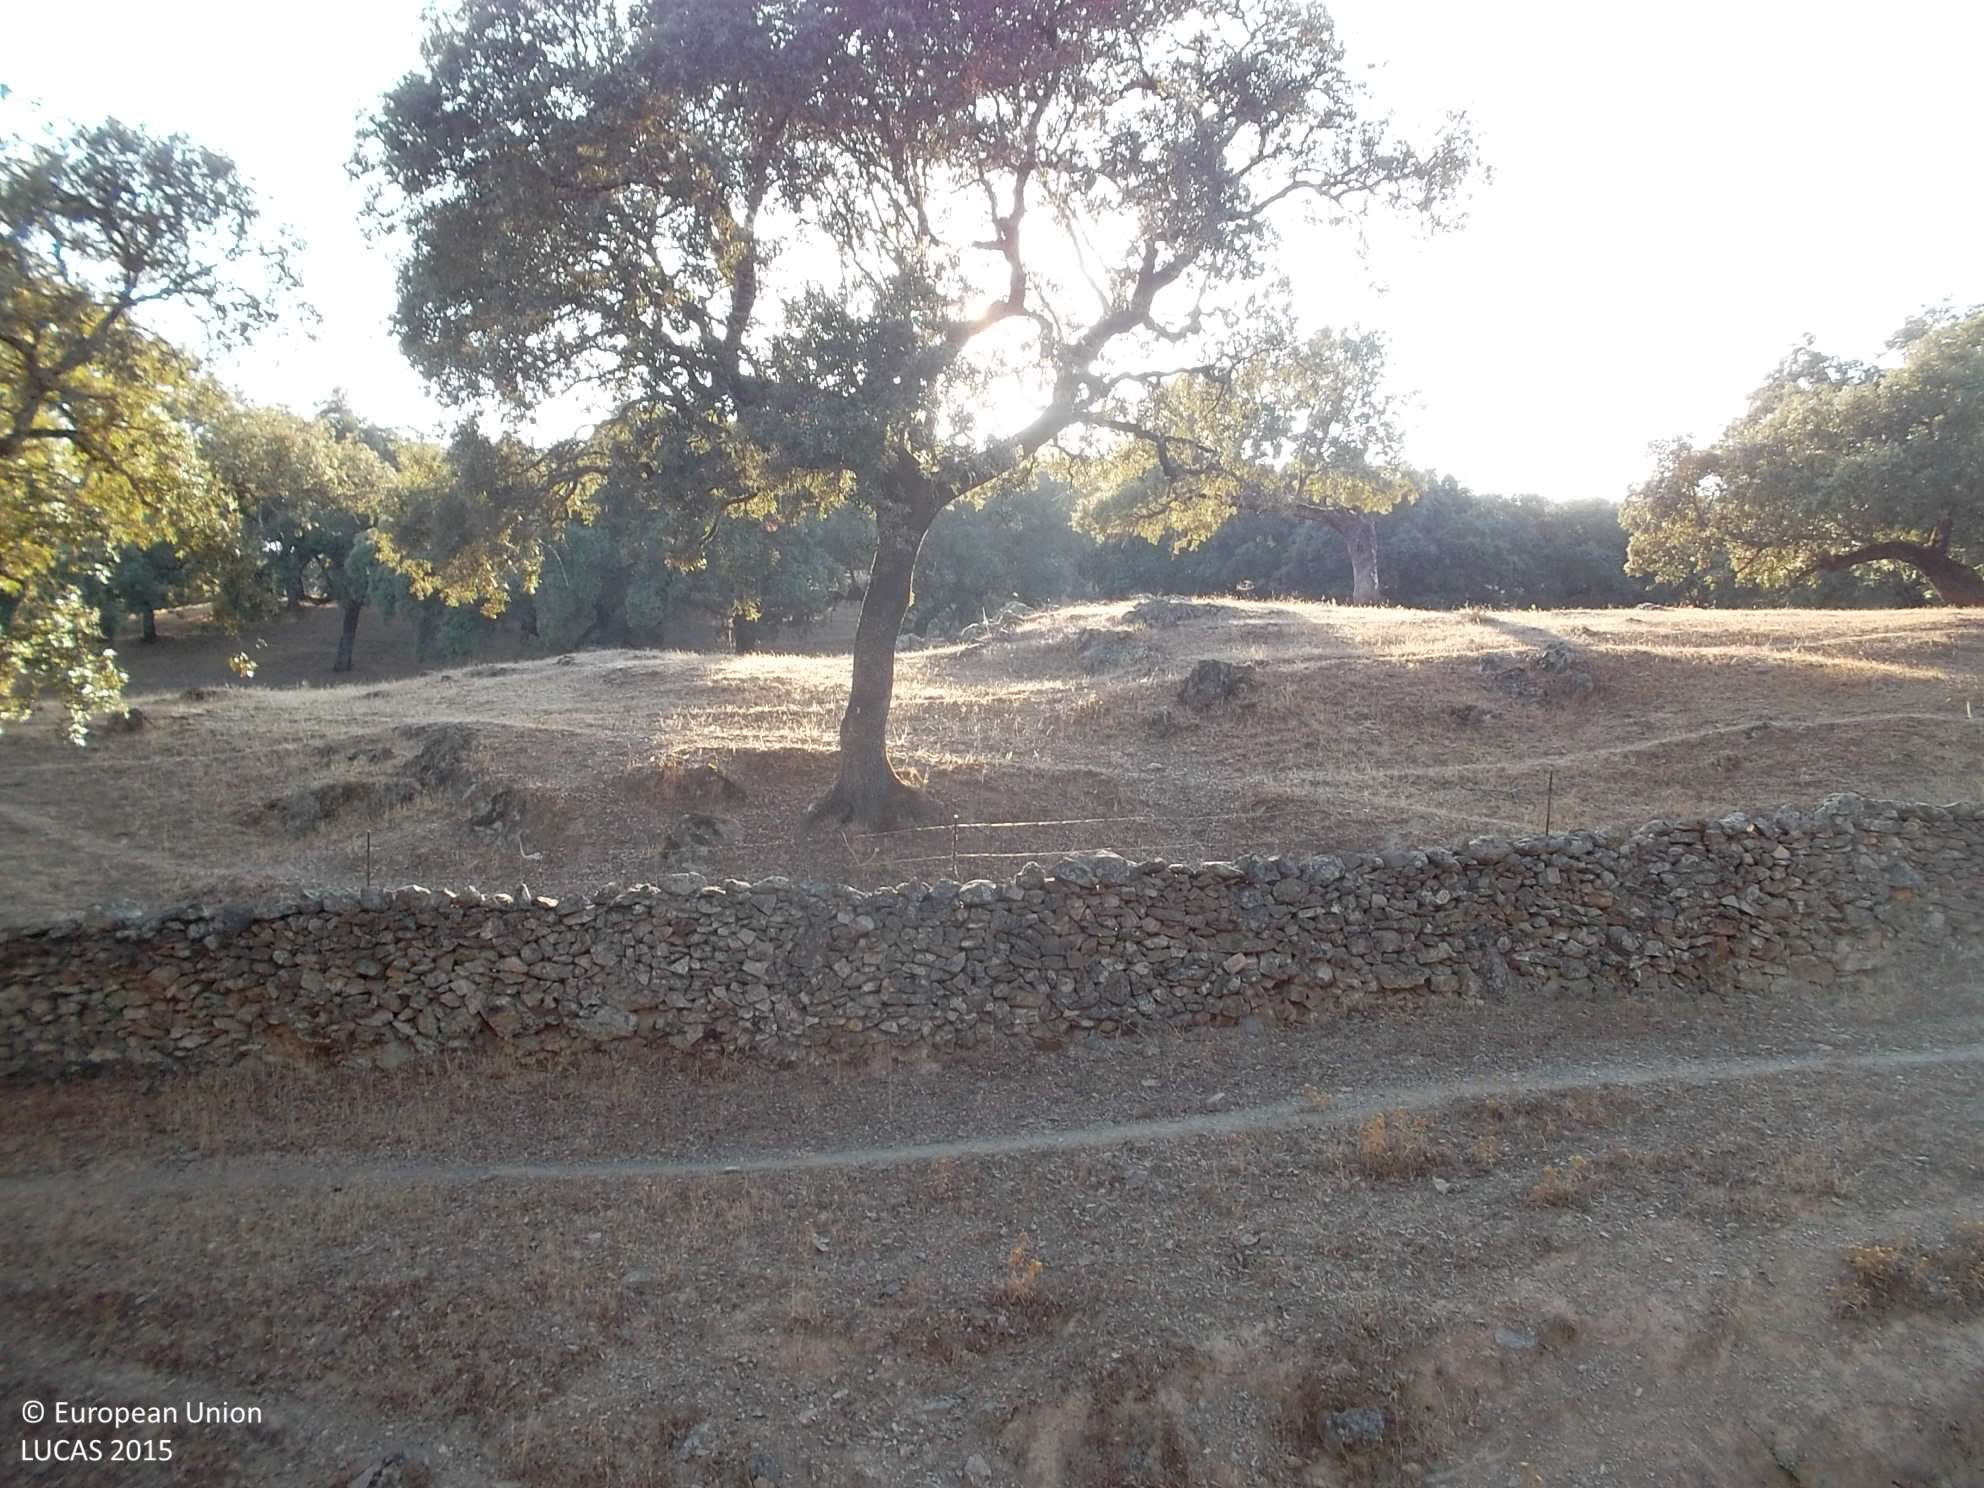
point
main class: Woodland
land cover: Broadleaved woodland
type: broadleaved evergreen forest
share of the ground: 10 - 25 %
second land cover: Grassland without tree/shrub cover
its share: > 75 %
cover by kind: herbaceous plants 80 %, broadleaved forest trees 20 %
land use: Forestry
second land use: Agriculture (excluding fallow land and kitchen gardens)
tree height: > 5 m
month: September
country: ES
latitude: 38.0425
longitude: -6.5335
